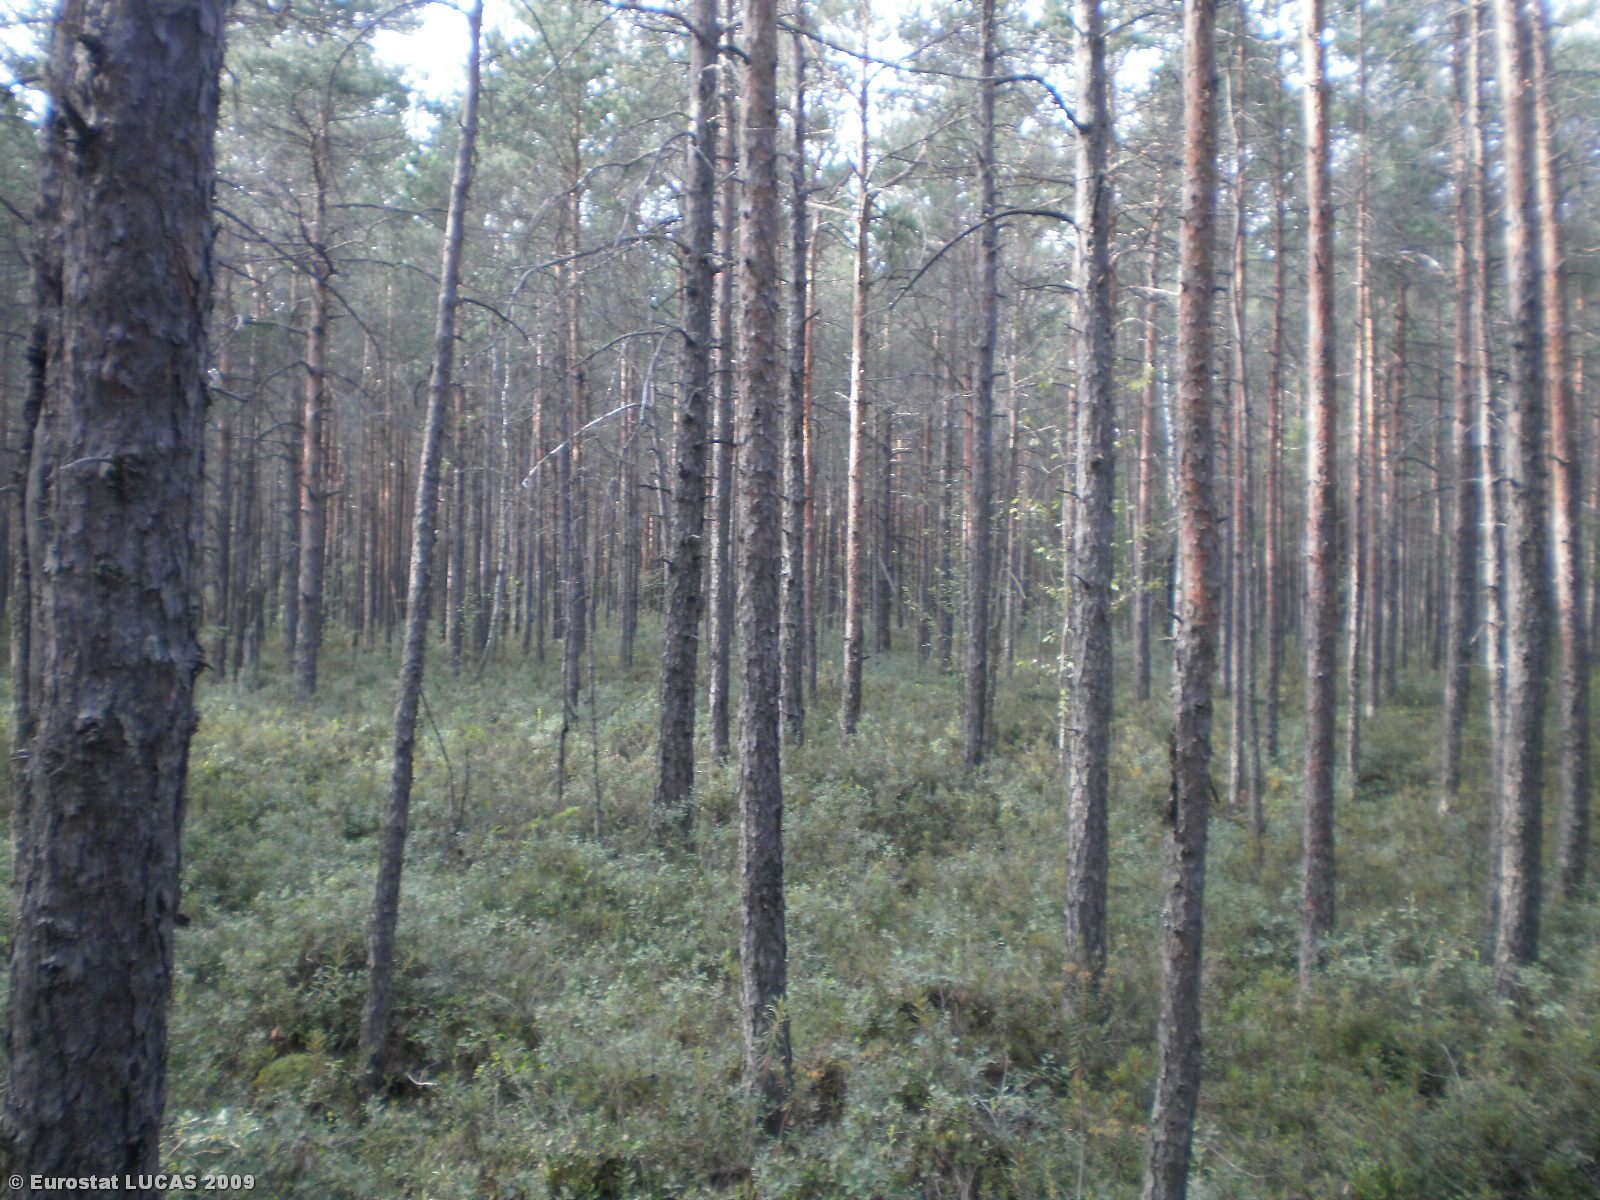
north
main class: Woodland
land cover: Coniferous woodland
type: hemiboreal forest and nemoral coniferous forest and mixed broadleaved-coniferous forest
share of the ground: > 75 %
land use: Forestry
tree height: > 5 m
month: July
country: LT
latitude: 55.7709
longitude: 25.6370
